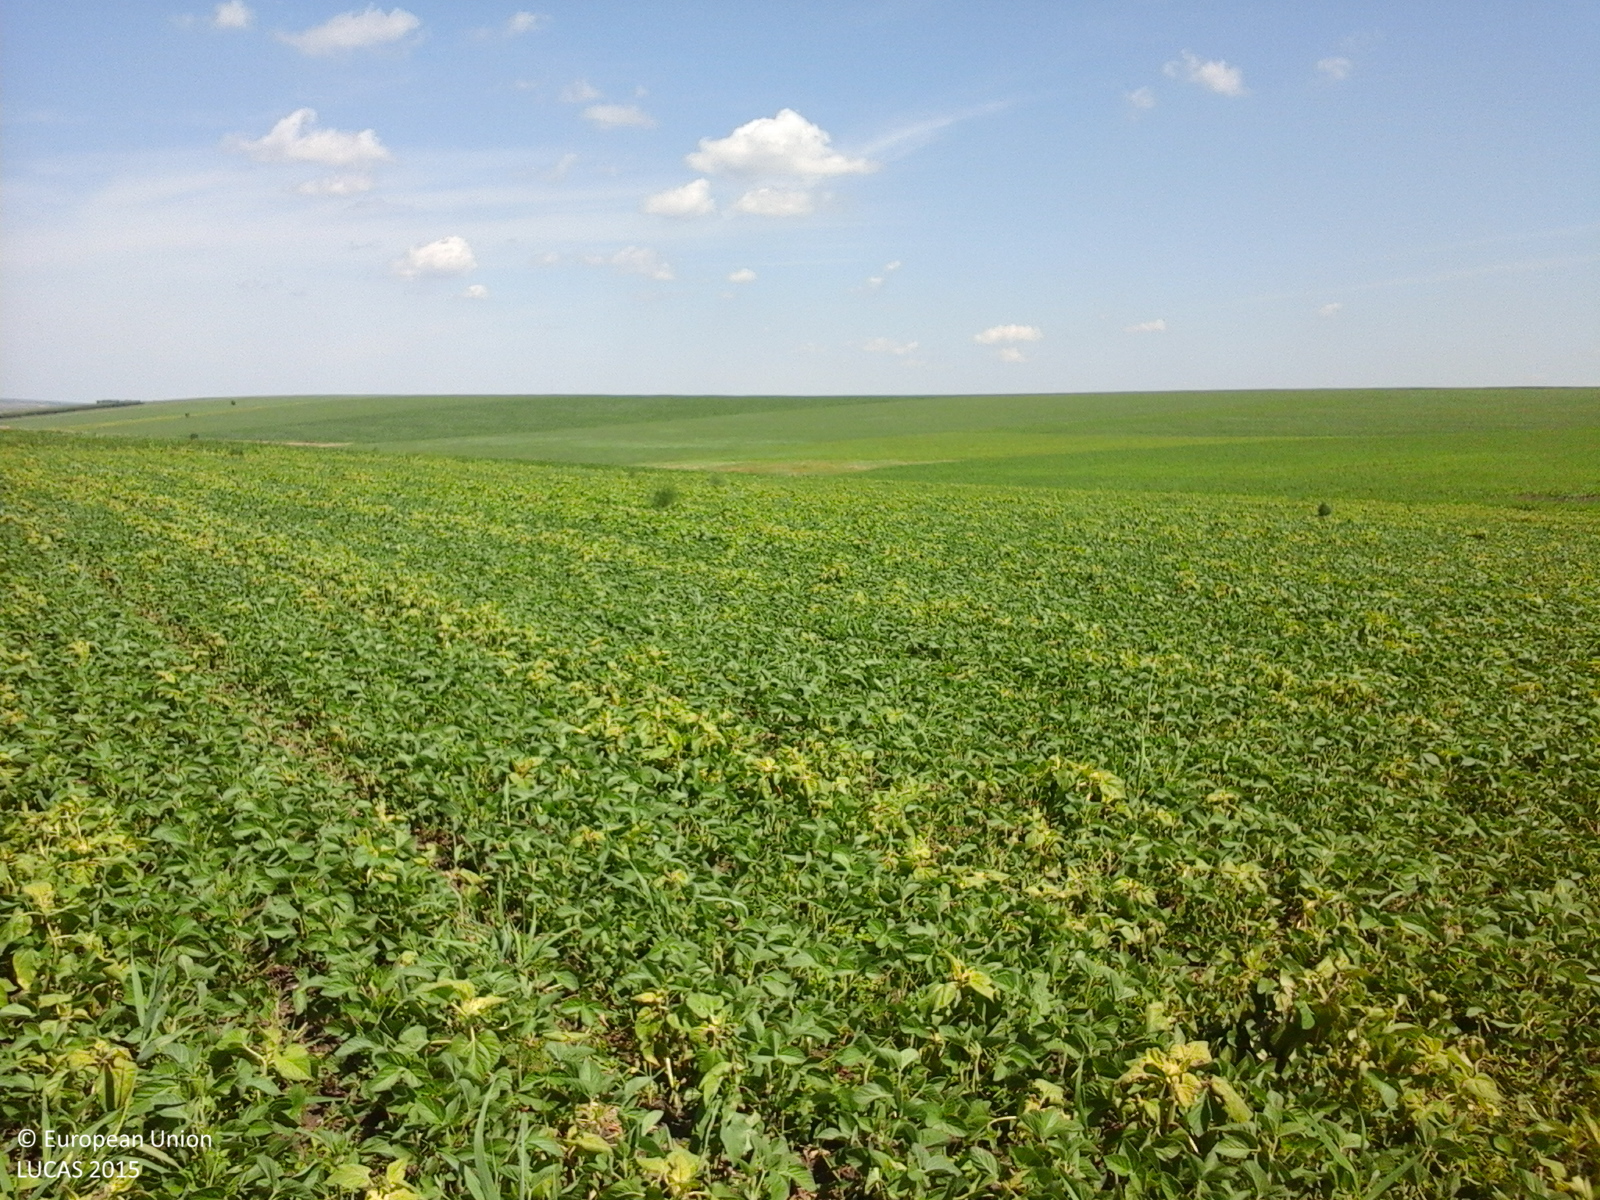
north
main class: Cropland
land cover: Soya
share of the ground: > 75 %
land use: Agriculture (excluding fallow land and kitchen gardens)
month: June
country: RO
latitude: 47.8344
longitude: 26.8408
